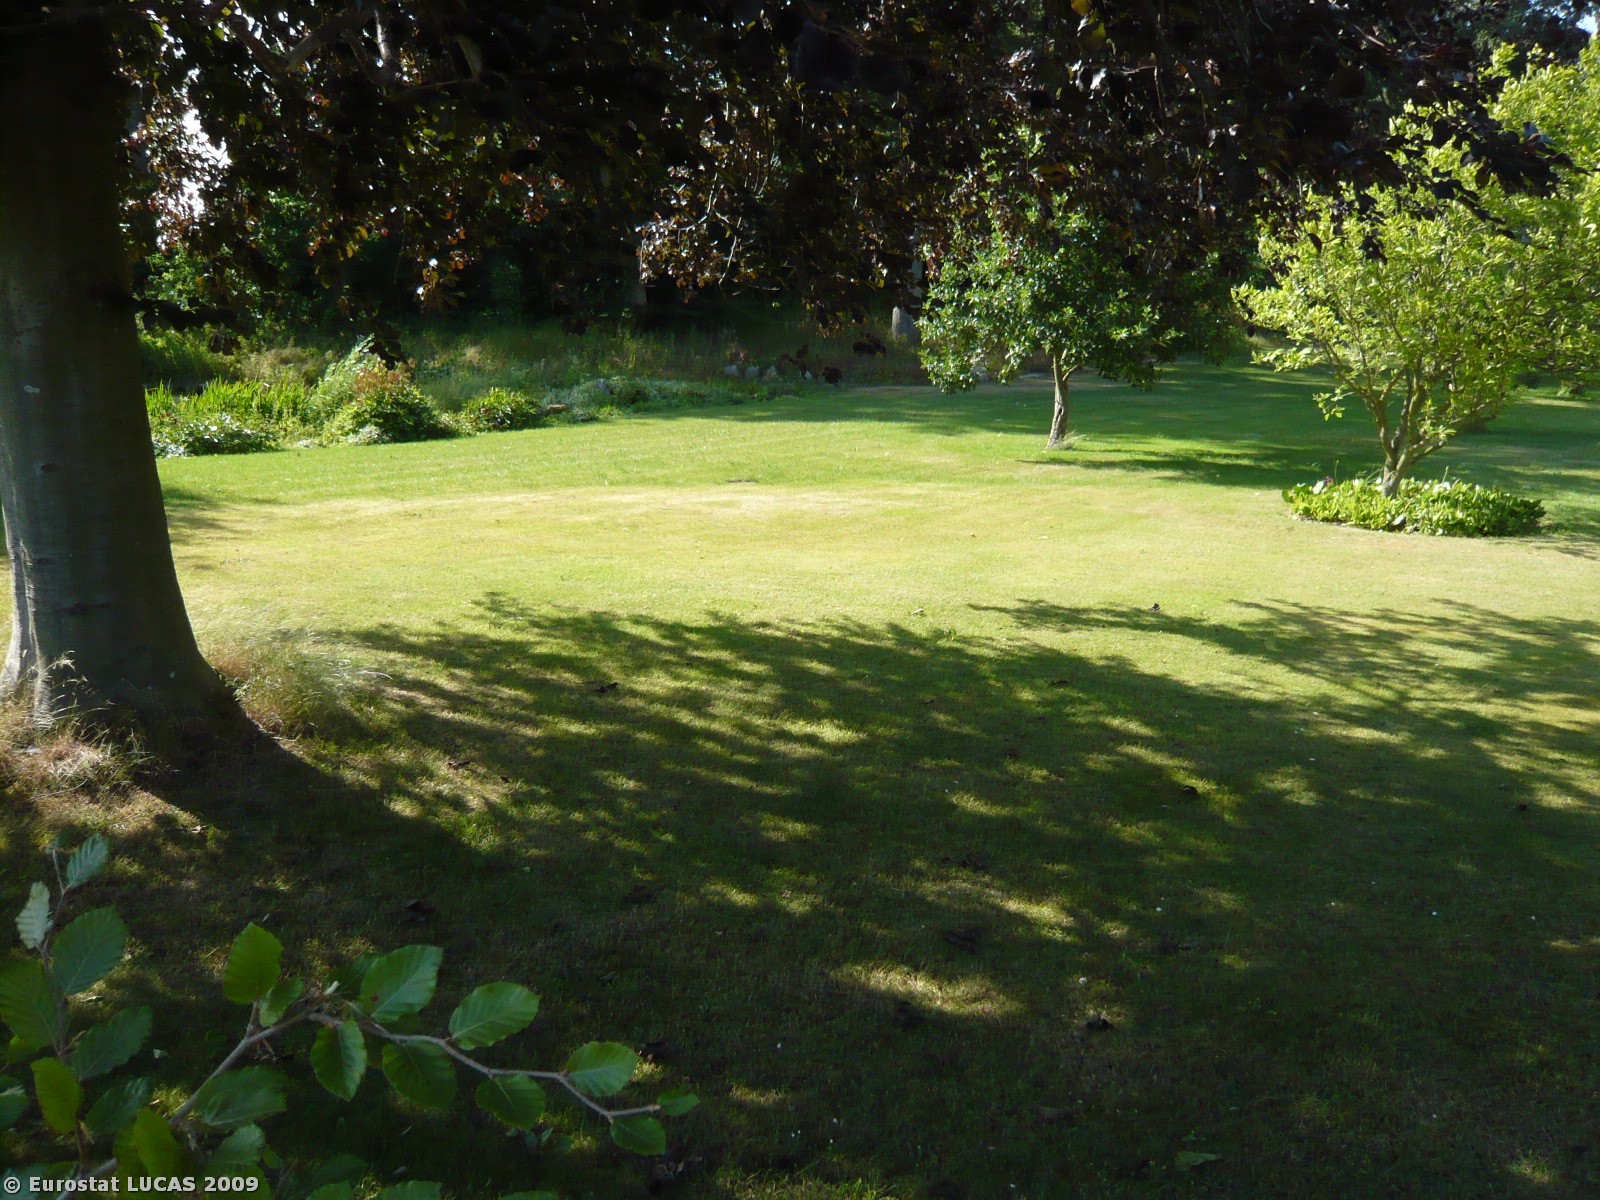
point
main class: Grassland
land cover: Grassland without tree/shrub cover
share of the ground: > 75 %
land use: Residential
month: July
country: DK
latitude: 55.3233
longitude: 10.6456
